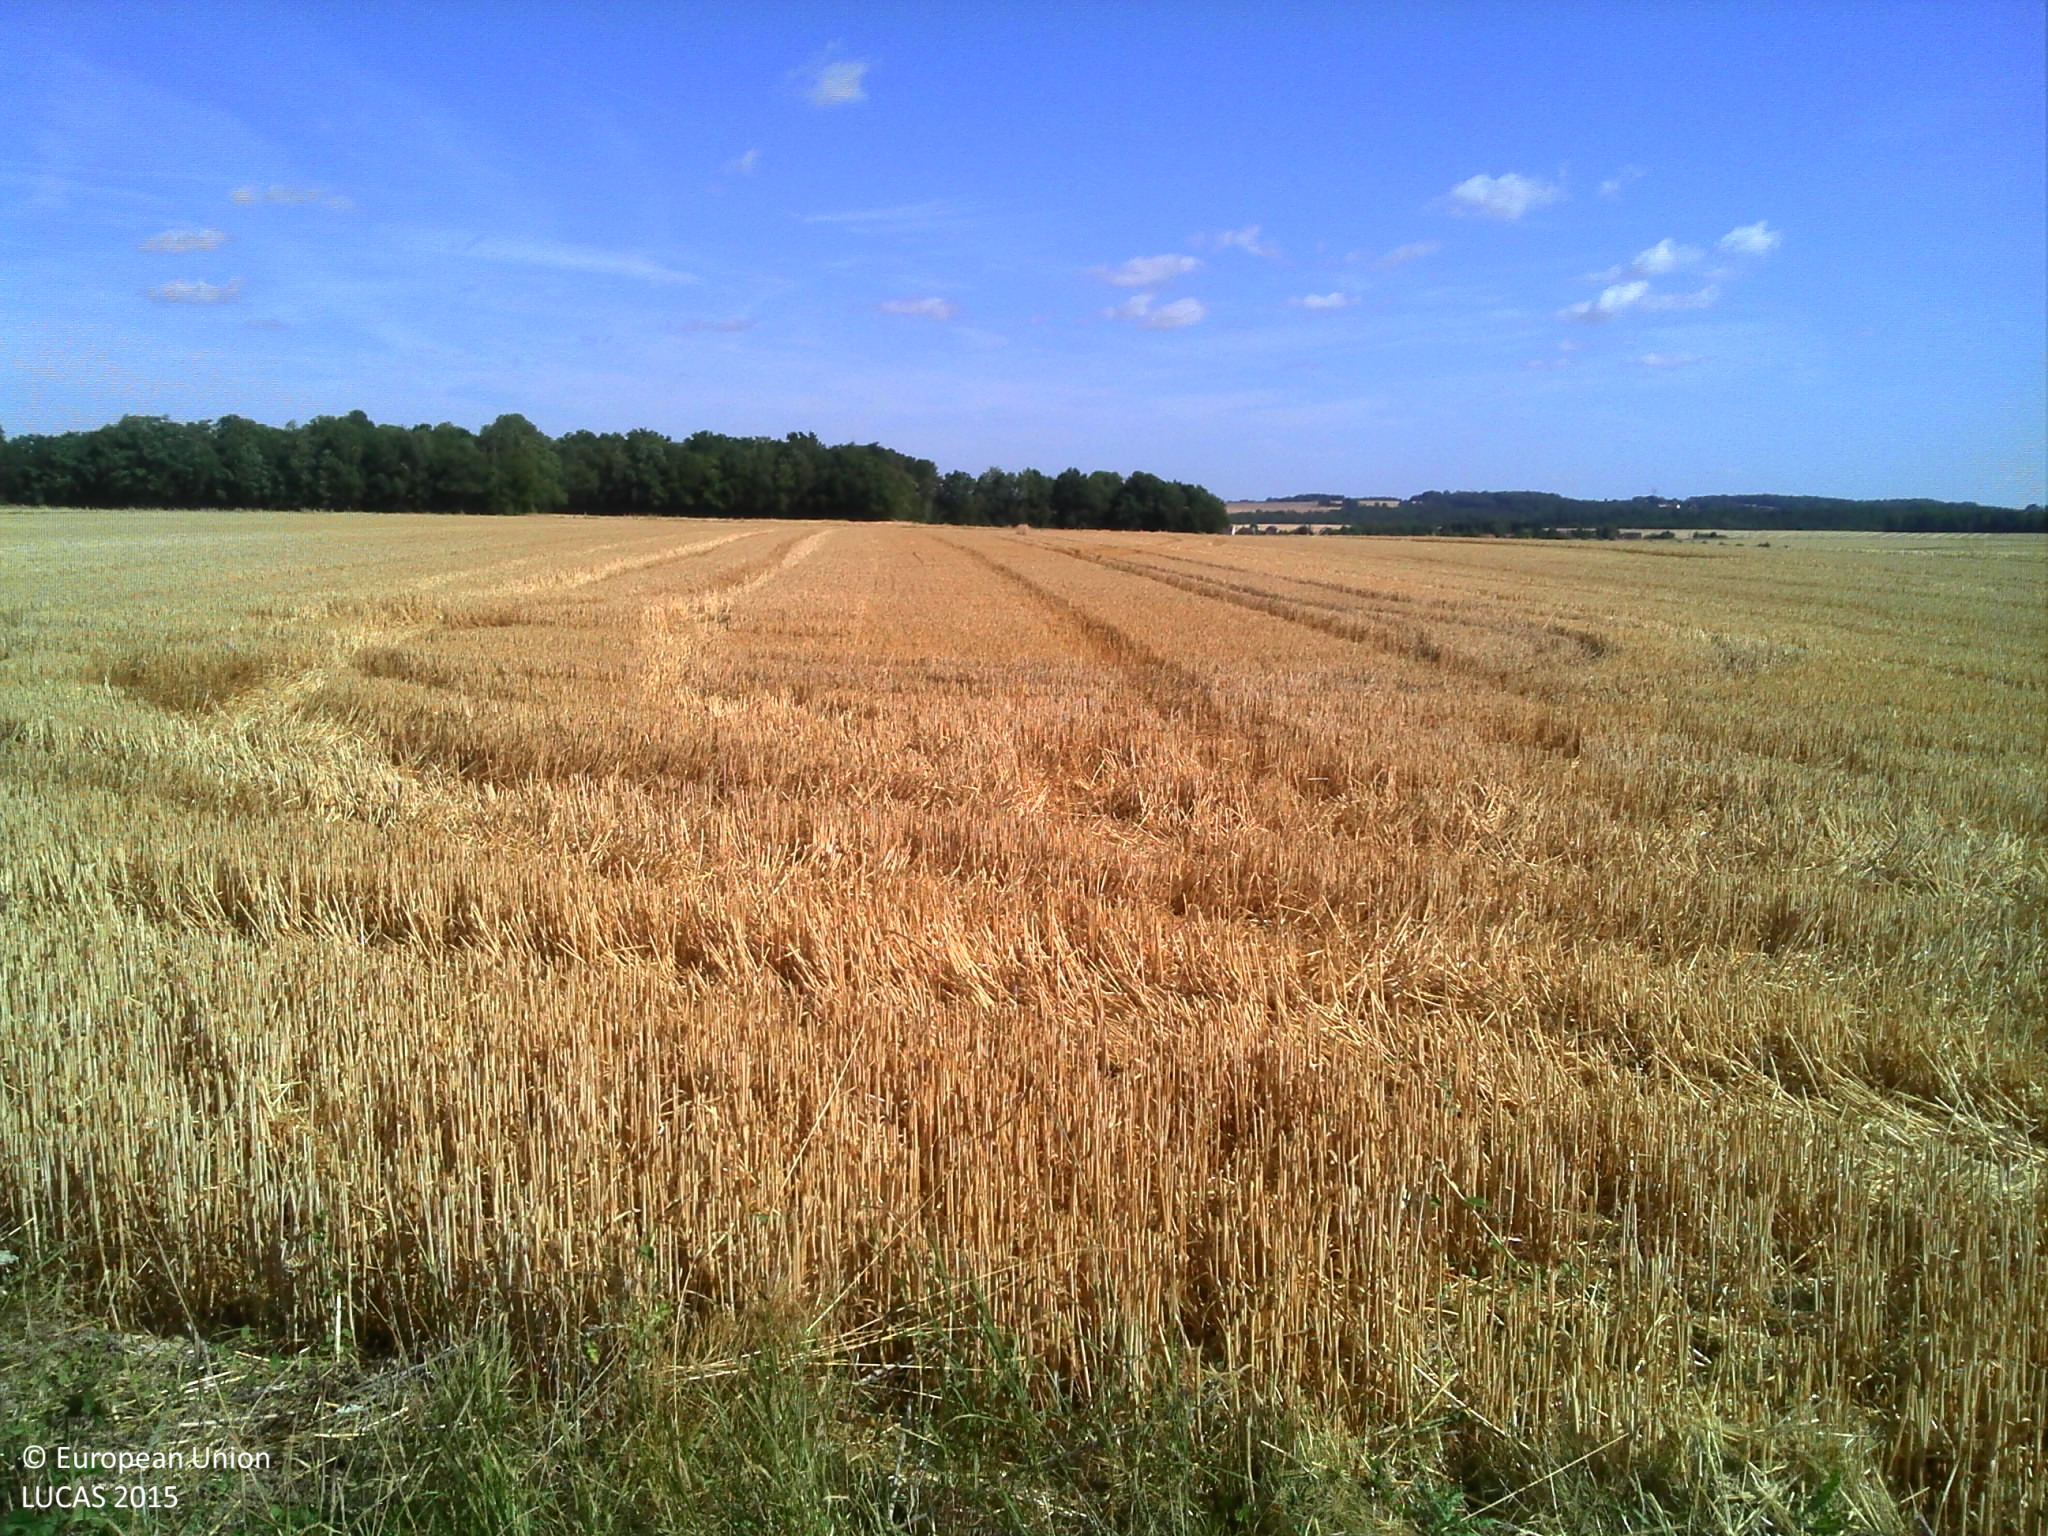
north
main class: Artificial land
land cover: Non built-up linear features
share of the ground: > 75 %
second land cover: Grassland without tree/shrub cover
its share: > 75 %
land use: Road transport
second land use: Agriculture (excluding fallow land and kitchen gardens)
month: August
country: FR
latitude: 48.7444
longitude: 3.3429
